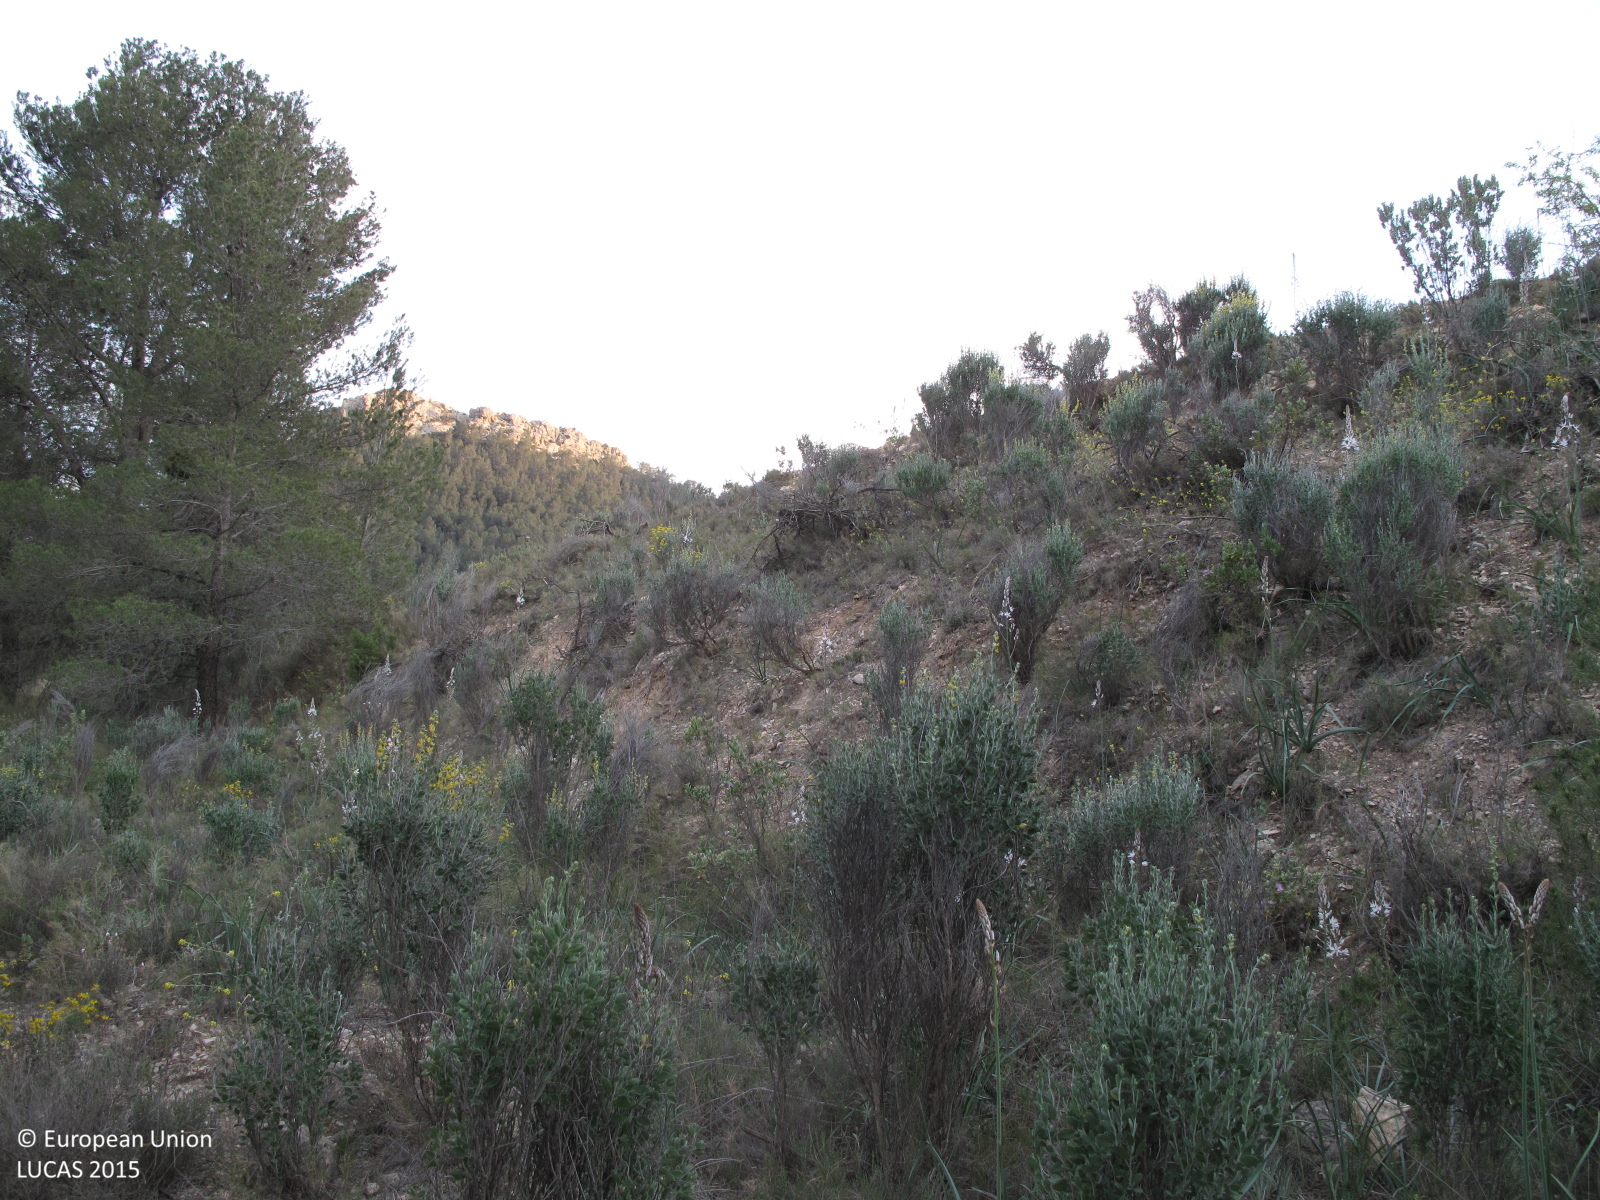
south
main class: Woodland
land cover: Pine dominated coniferous woodland
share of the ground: 25 - 50 %
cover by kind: coniferous forest trees 40 %, shrubs 30 %, herbaceous plants 20 %, consolidated bare surface 10 %
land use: Semi-natural and natural areas not in use
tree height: > 5 m
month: April
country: ES
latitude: 38.4984
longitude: -0.6628
